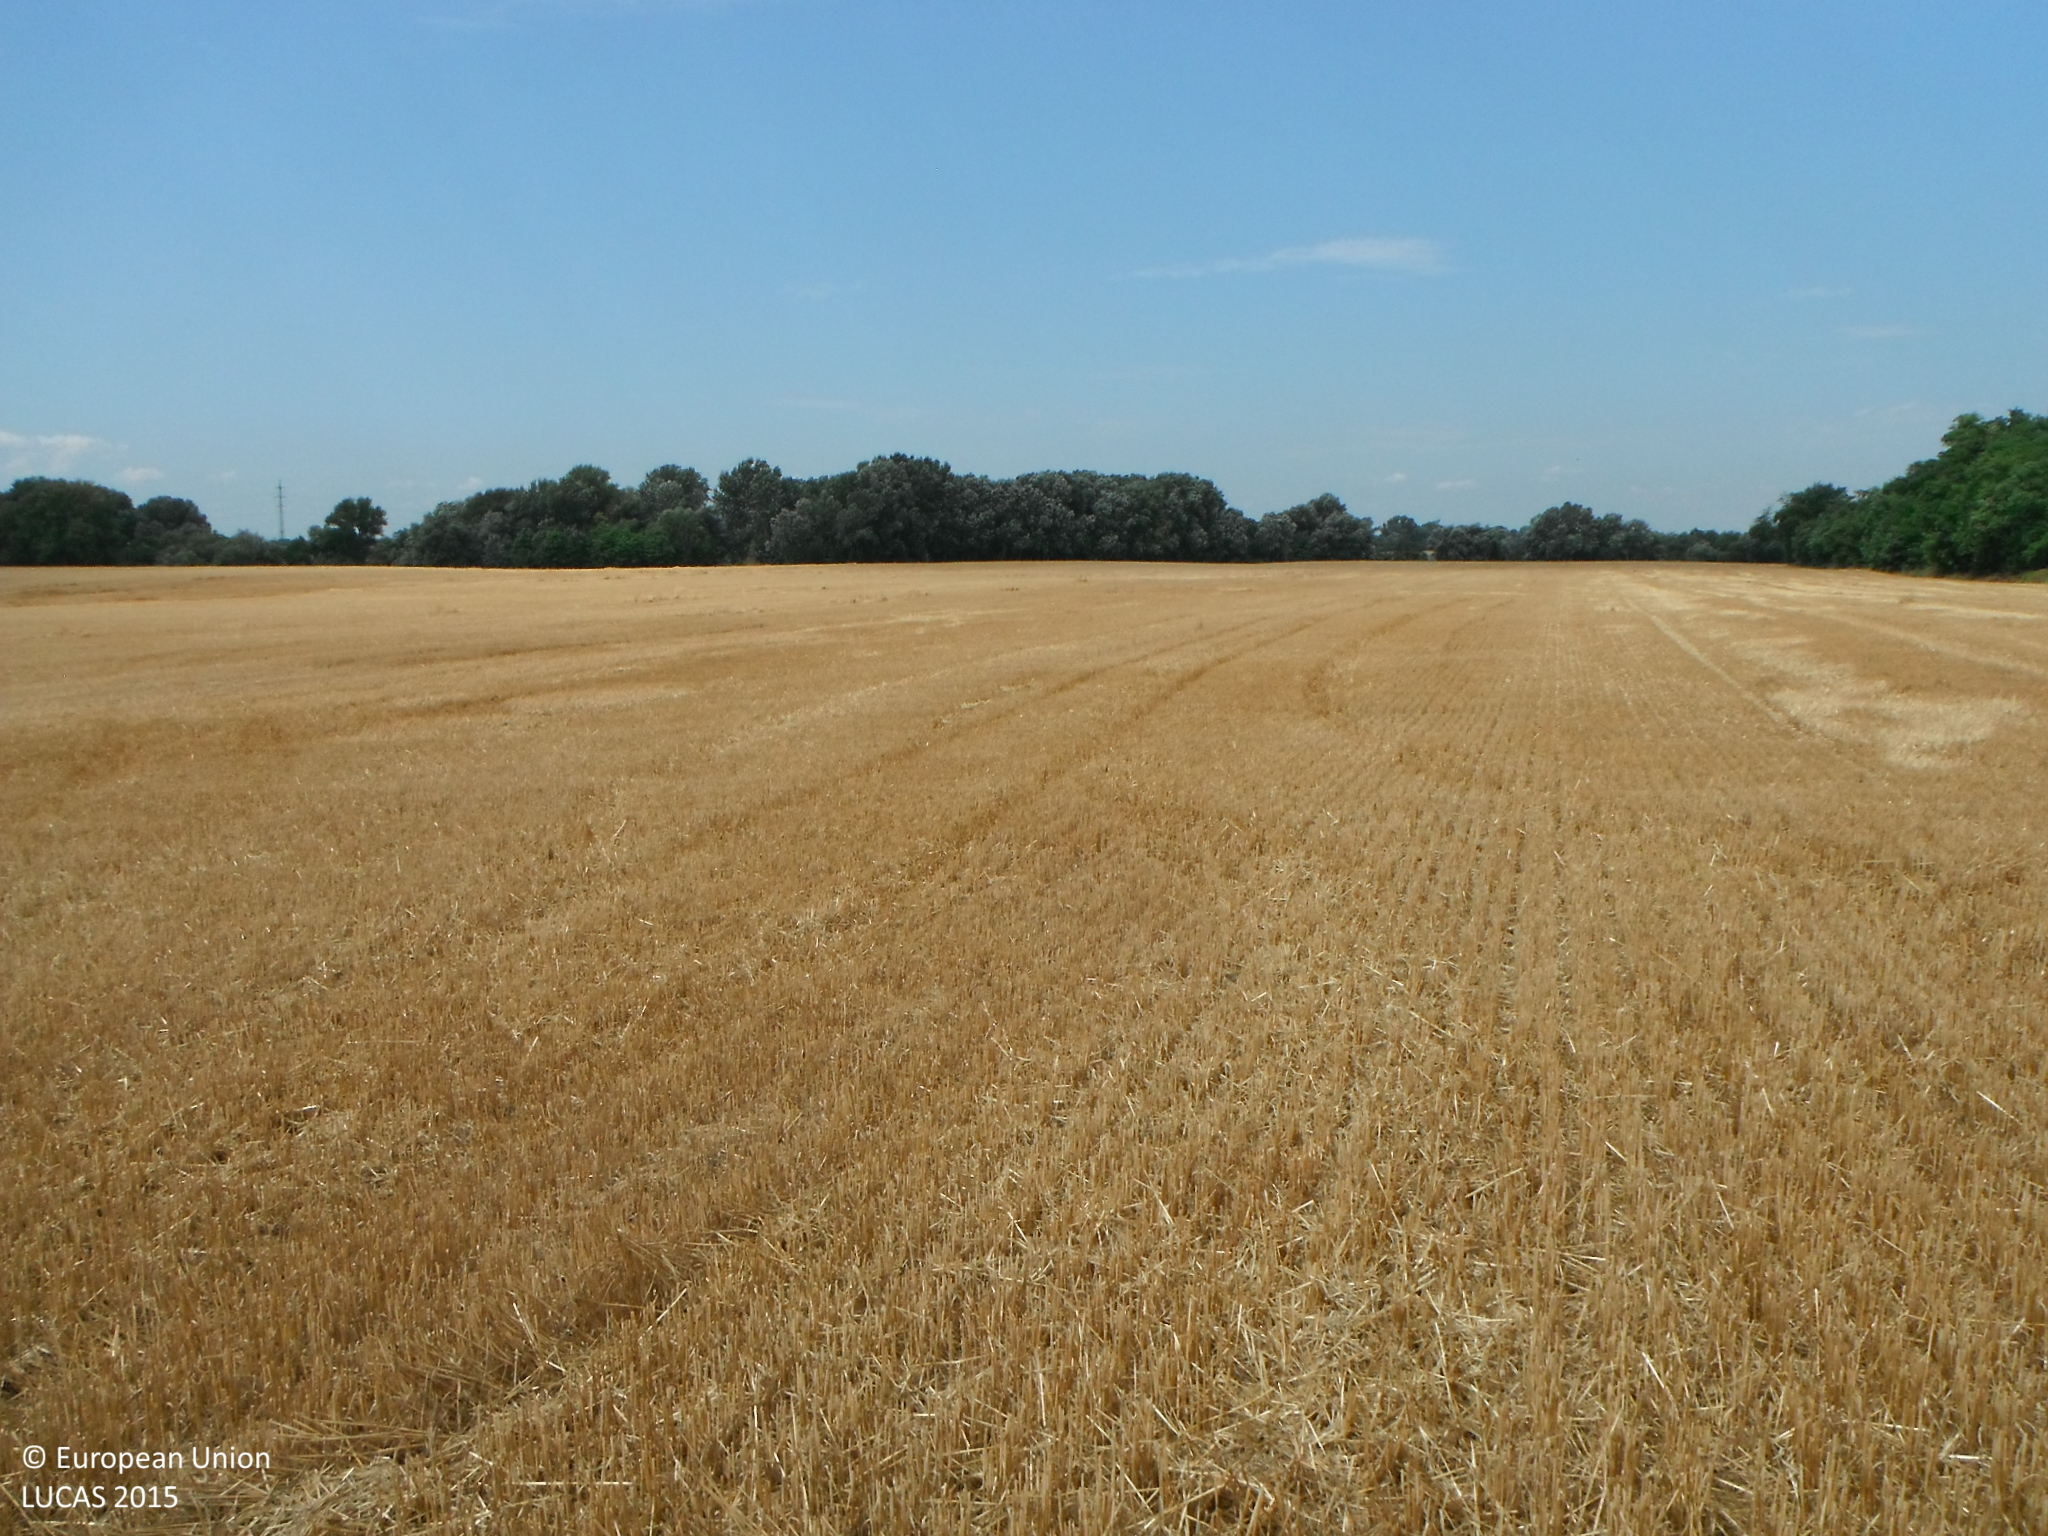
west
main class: Cropland
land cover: Common wheat
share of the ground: > 75 %
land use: Agriculture (excluding fallow land and kitchen gardens)
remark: Harvested field
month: August
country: SK
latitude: 47.8165
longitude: 18.5763
